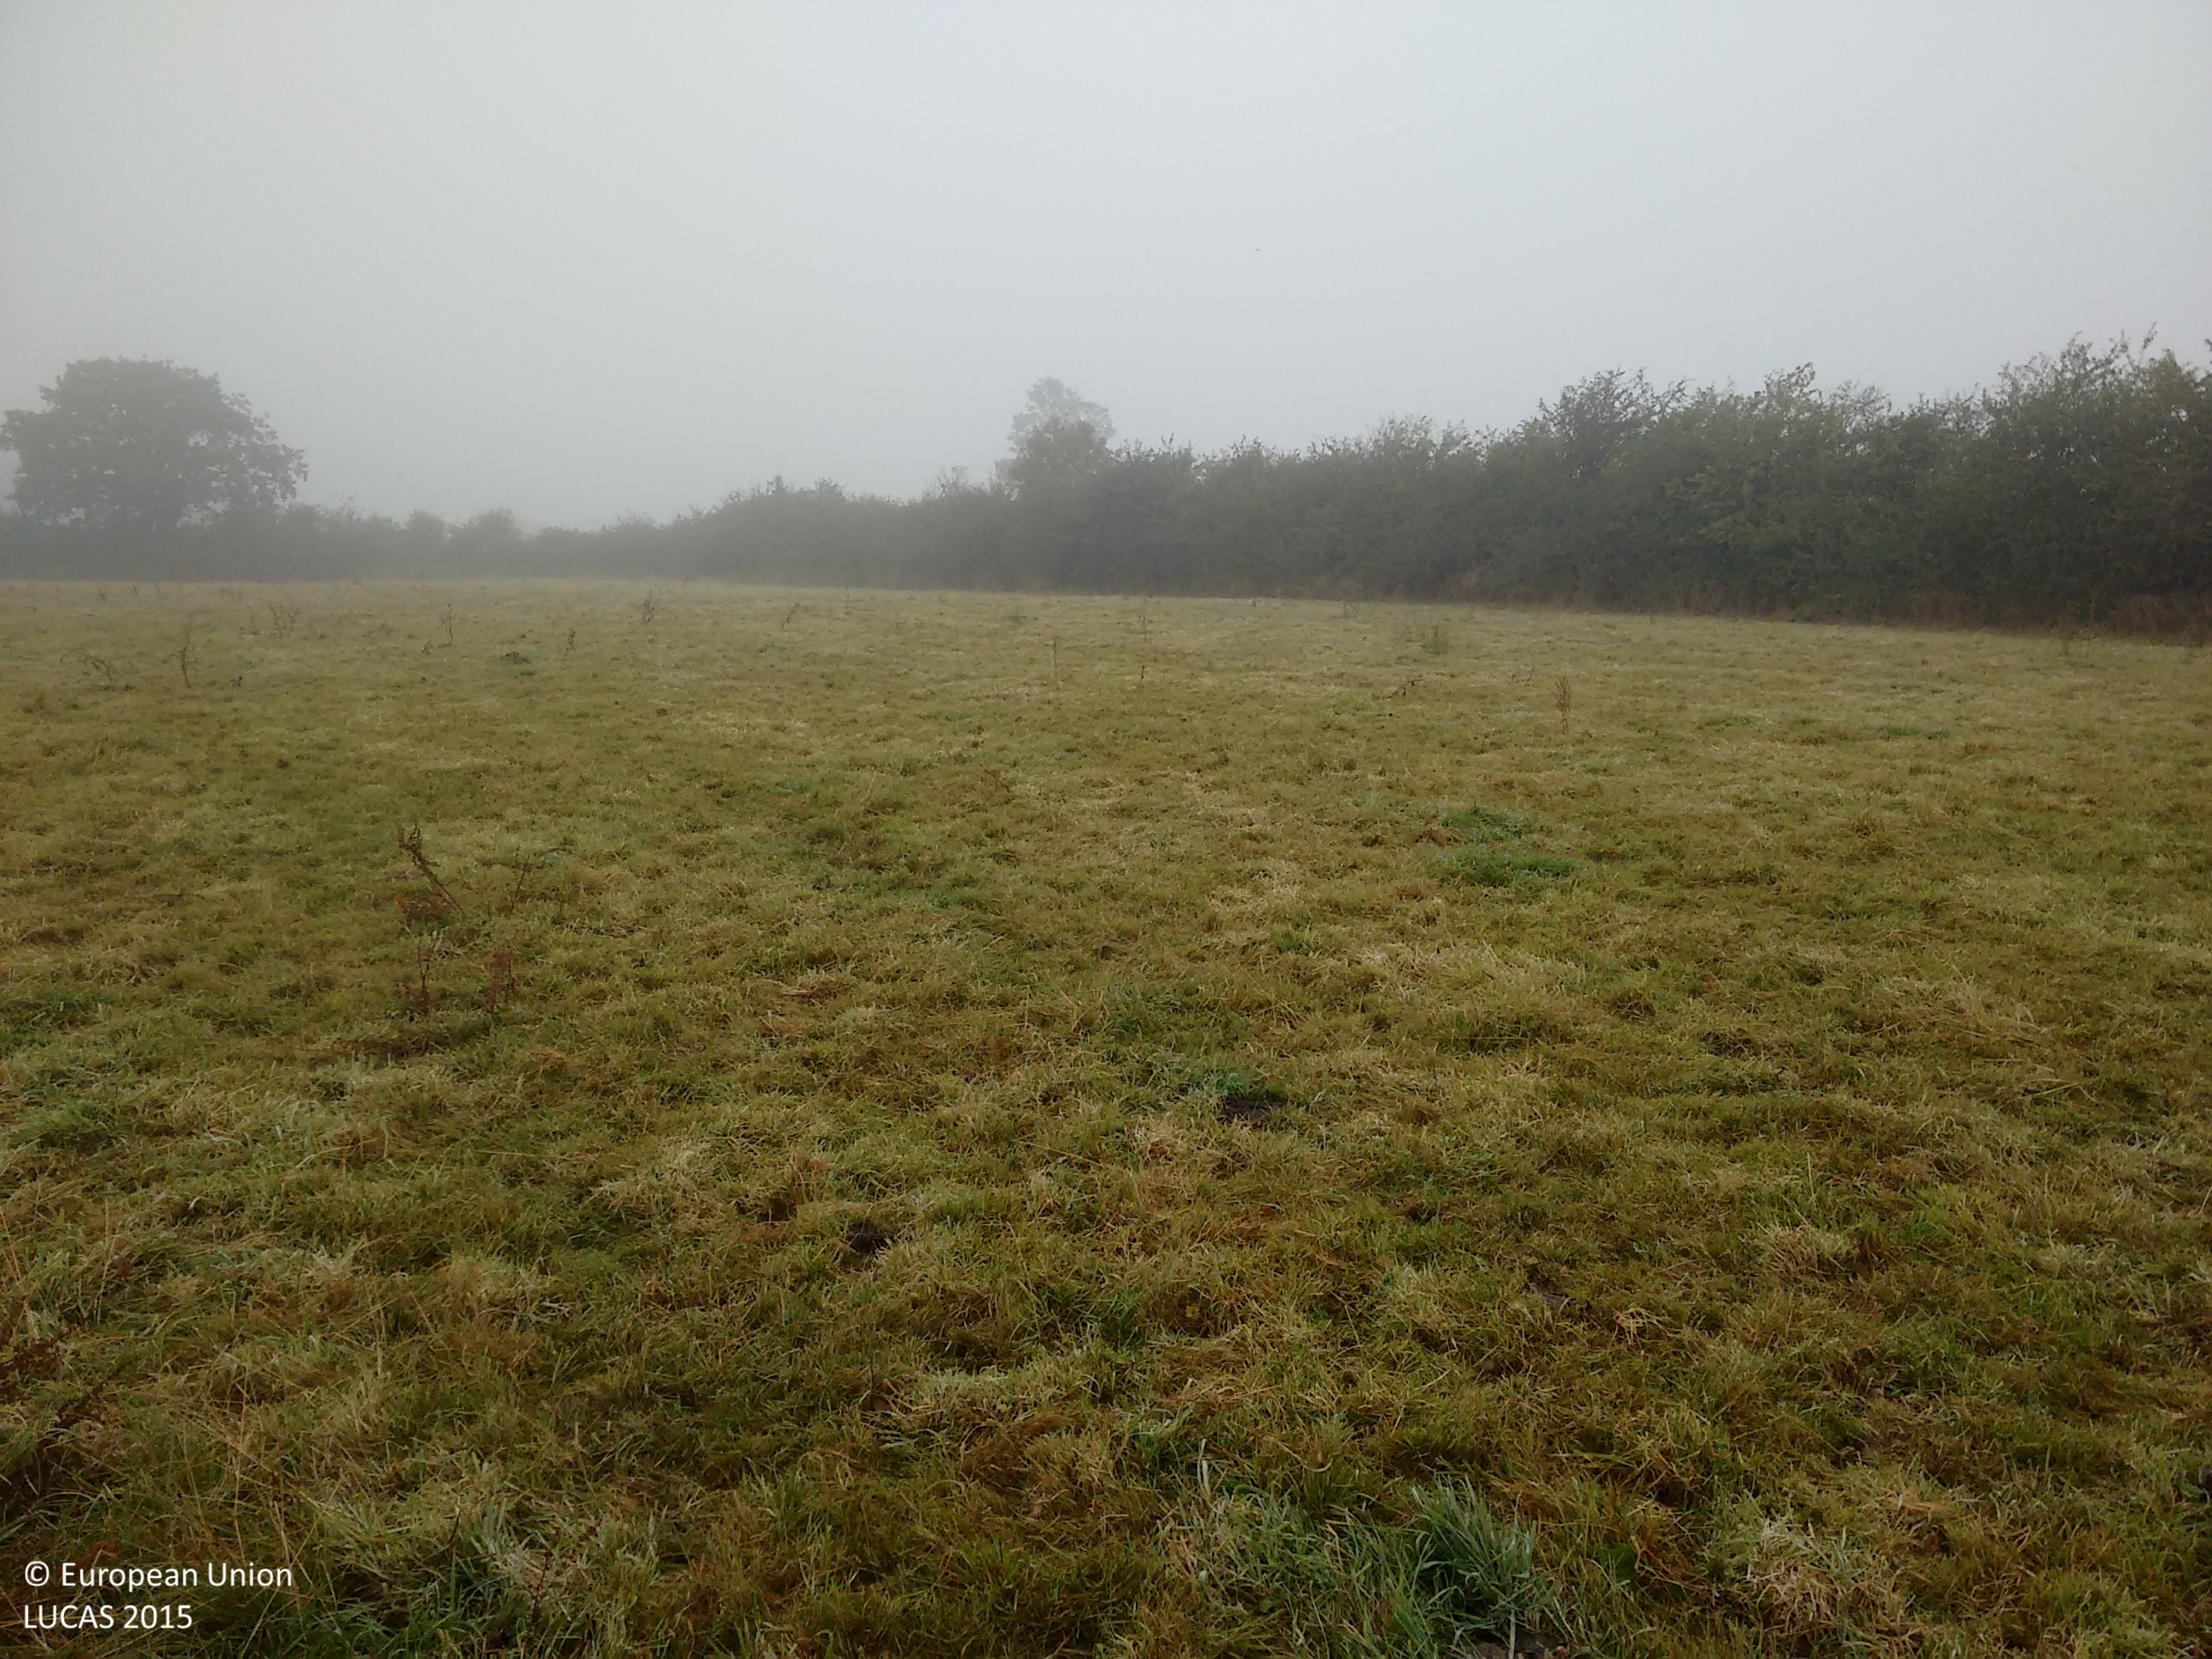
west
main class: Grassland
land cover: Grassland without tree/shrub cover
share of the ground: > 75 %
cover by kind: herbaceous plants 100 %
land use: Agriculture (excluding fallow land and kitchen gardens)
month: October
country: IE
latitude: 52.4448
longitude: -9.0314
